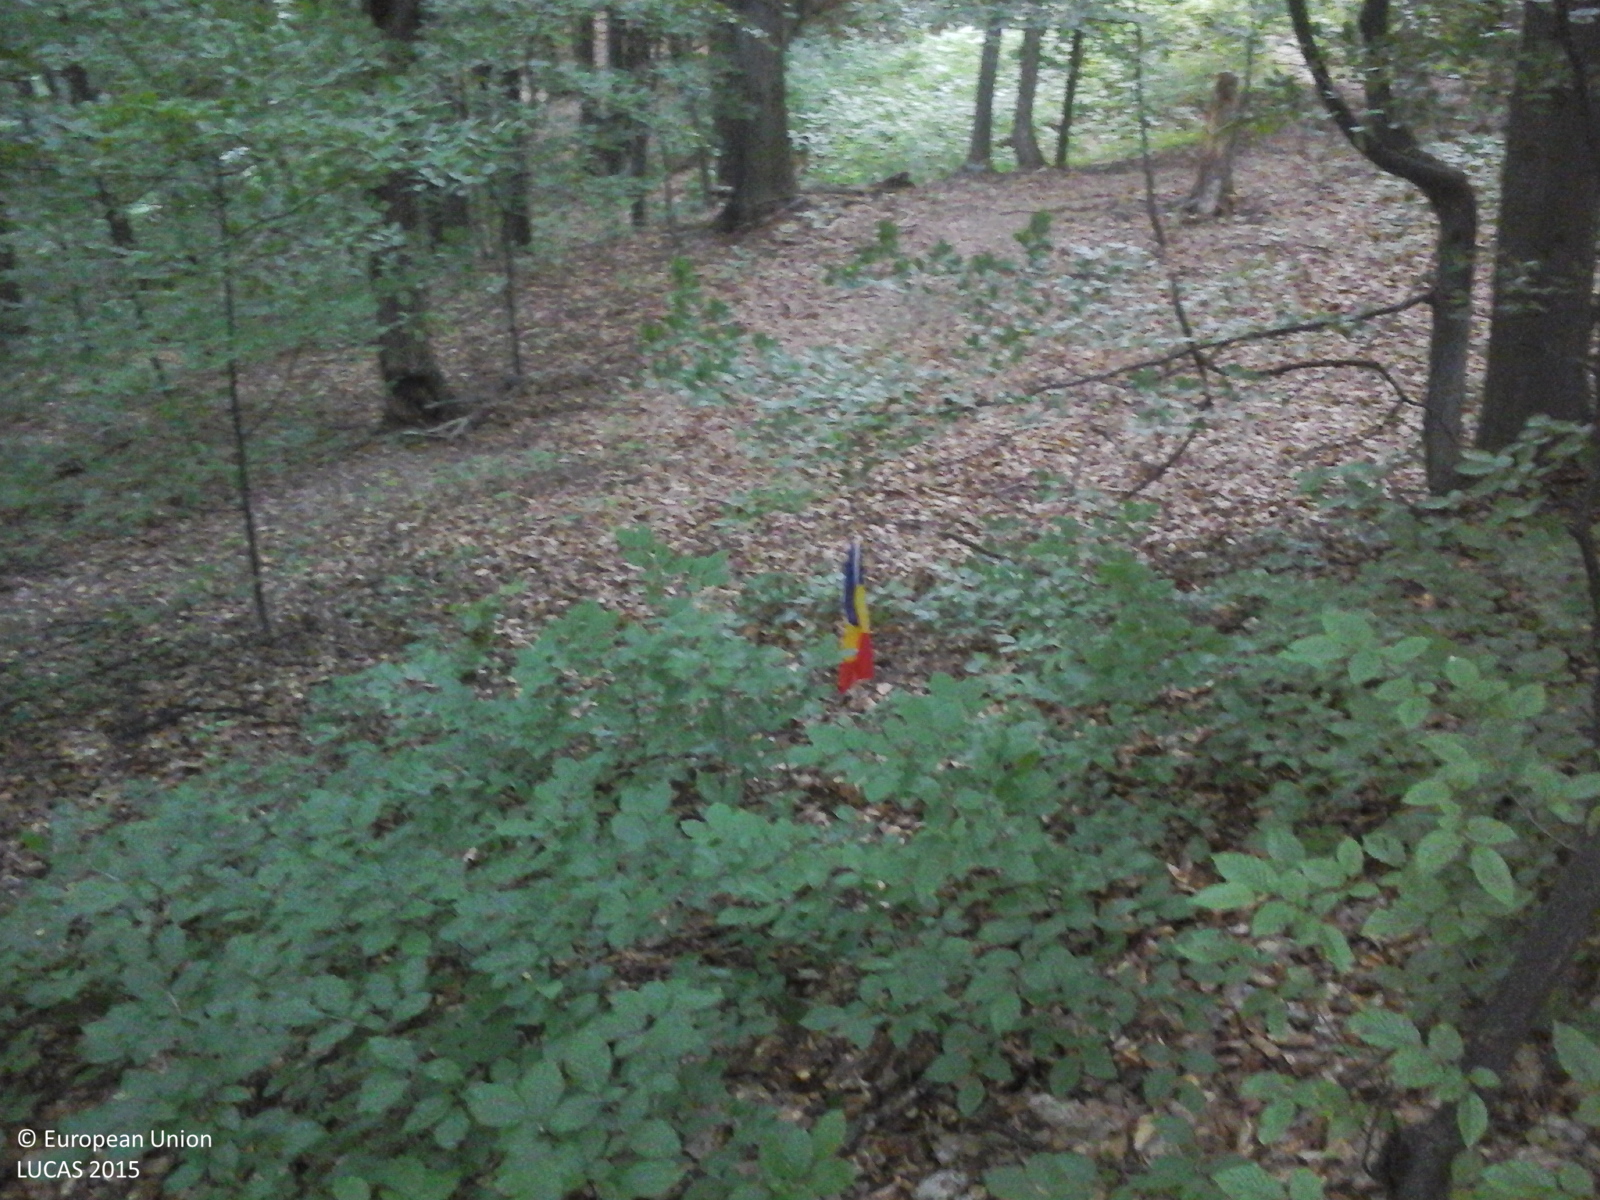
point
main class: Woodland
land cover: Broadleaved woodland
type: beech forest
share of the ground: > 75 %
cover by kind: broadleaved forest trees 100 %
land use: Forestry
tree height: > 5 m
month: June
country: RO
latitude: 46.6161
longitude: 26.5236
